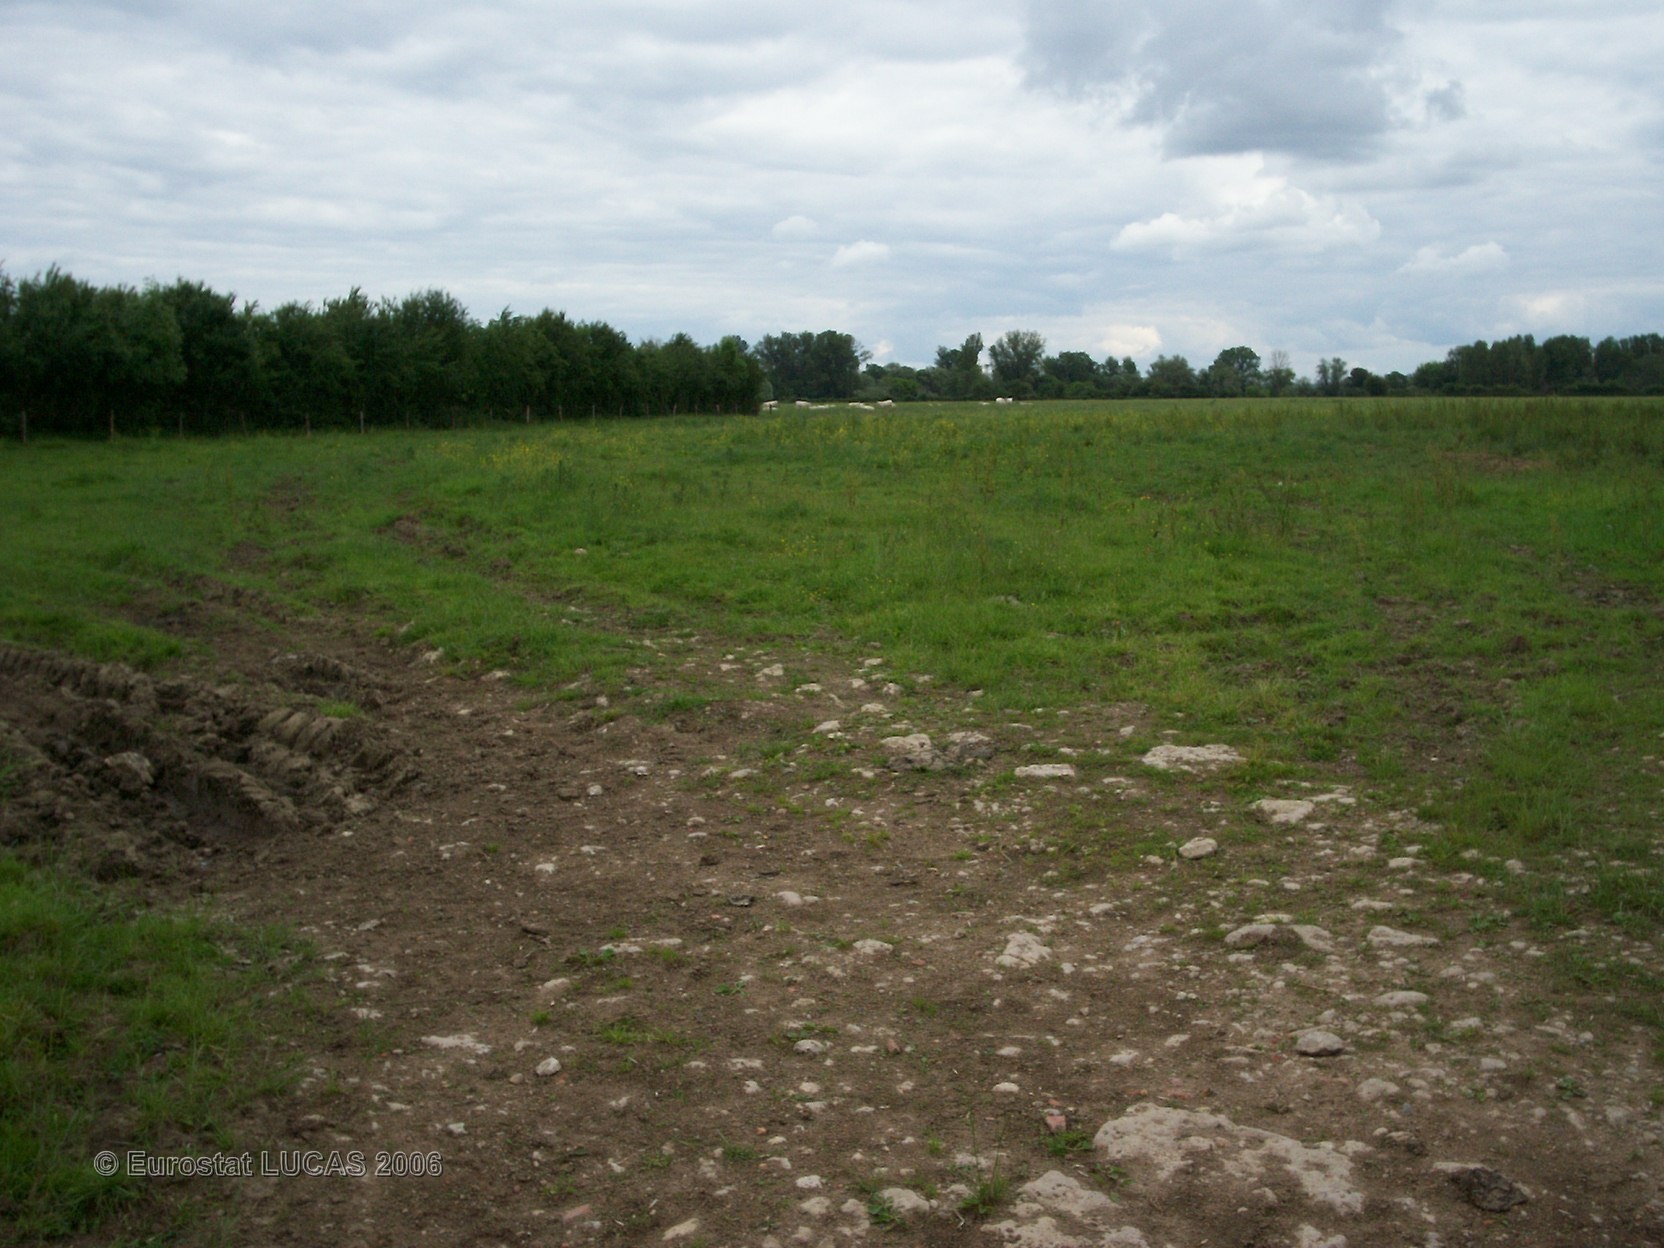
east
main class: Grassland
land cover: Grassland without tree/shrub cover
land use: Agriculture (excluding fallow land and kitchen gardens)
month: May
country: FR
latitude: 46.8664
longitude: 3.0566
